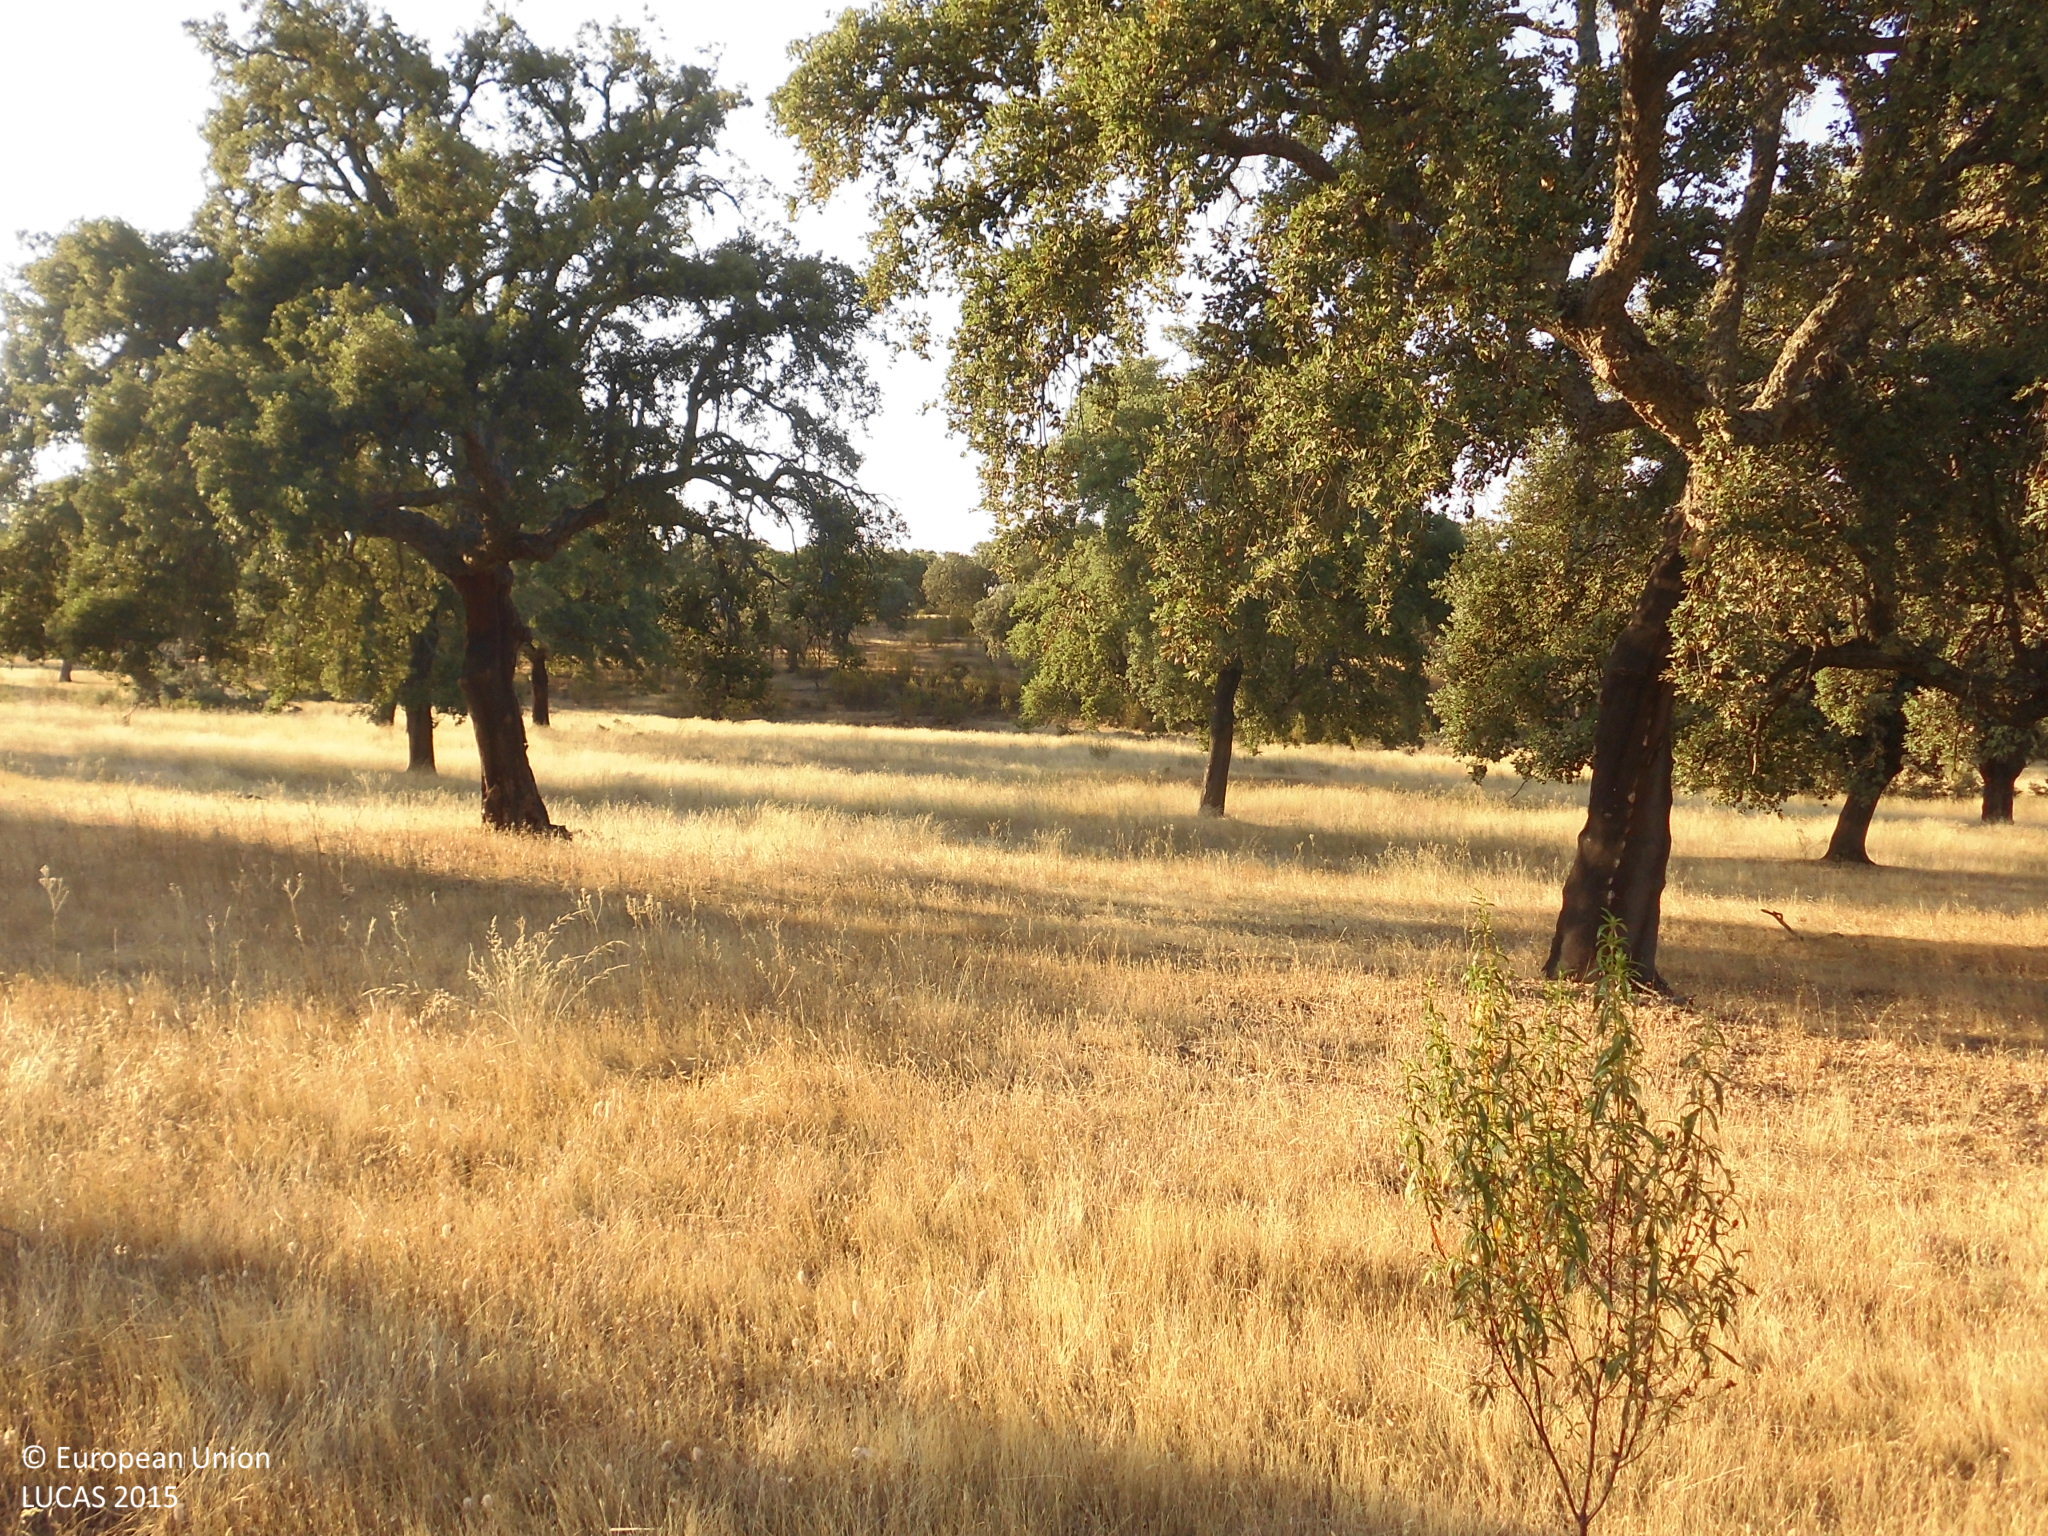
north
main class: Woodland
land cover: Broadleaved woodland
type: broadleaved evergreen forest
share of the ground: 10 - 25 %
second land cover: Grassland without tree/shrub cover
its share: > 75 %
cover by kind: herbaceous plants 60 %, broadleaved forest trees 30 %, shrubs 10 %
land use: Forestry
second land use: Agriculture (excluding fallow land and kitchen gardens)
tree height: > 5 m
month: June
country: ES
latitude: 39.9213
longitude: -5.9913
